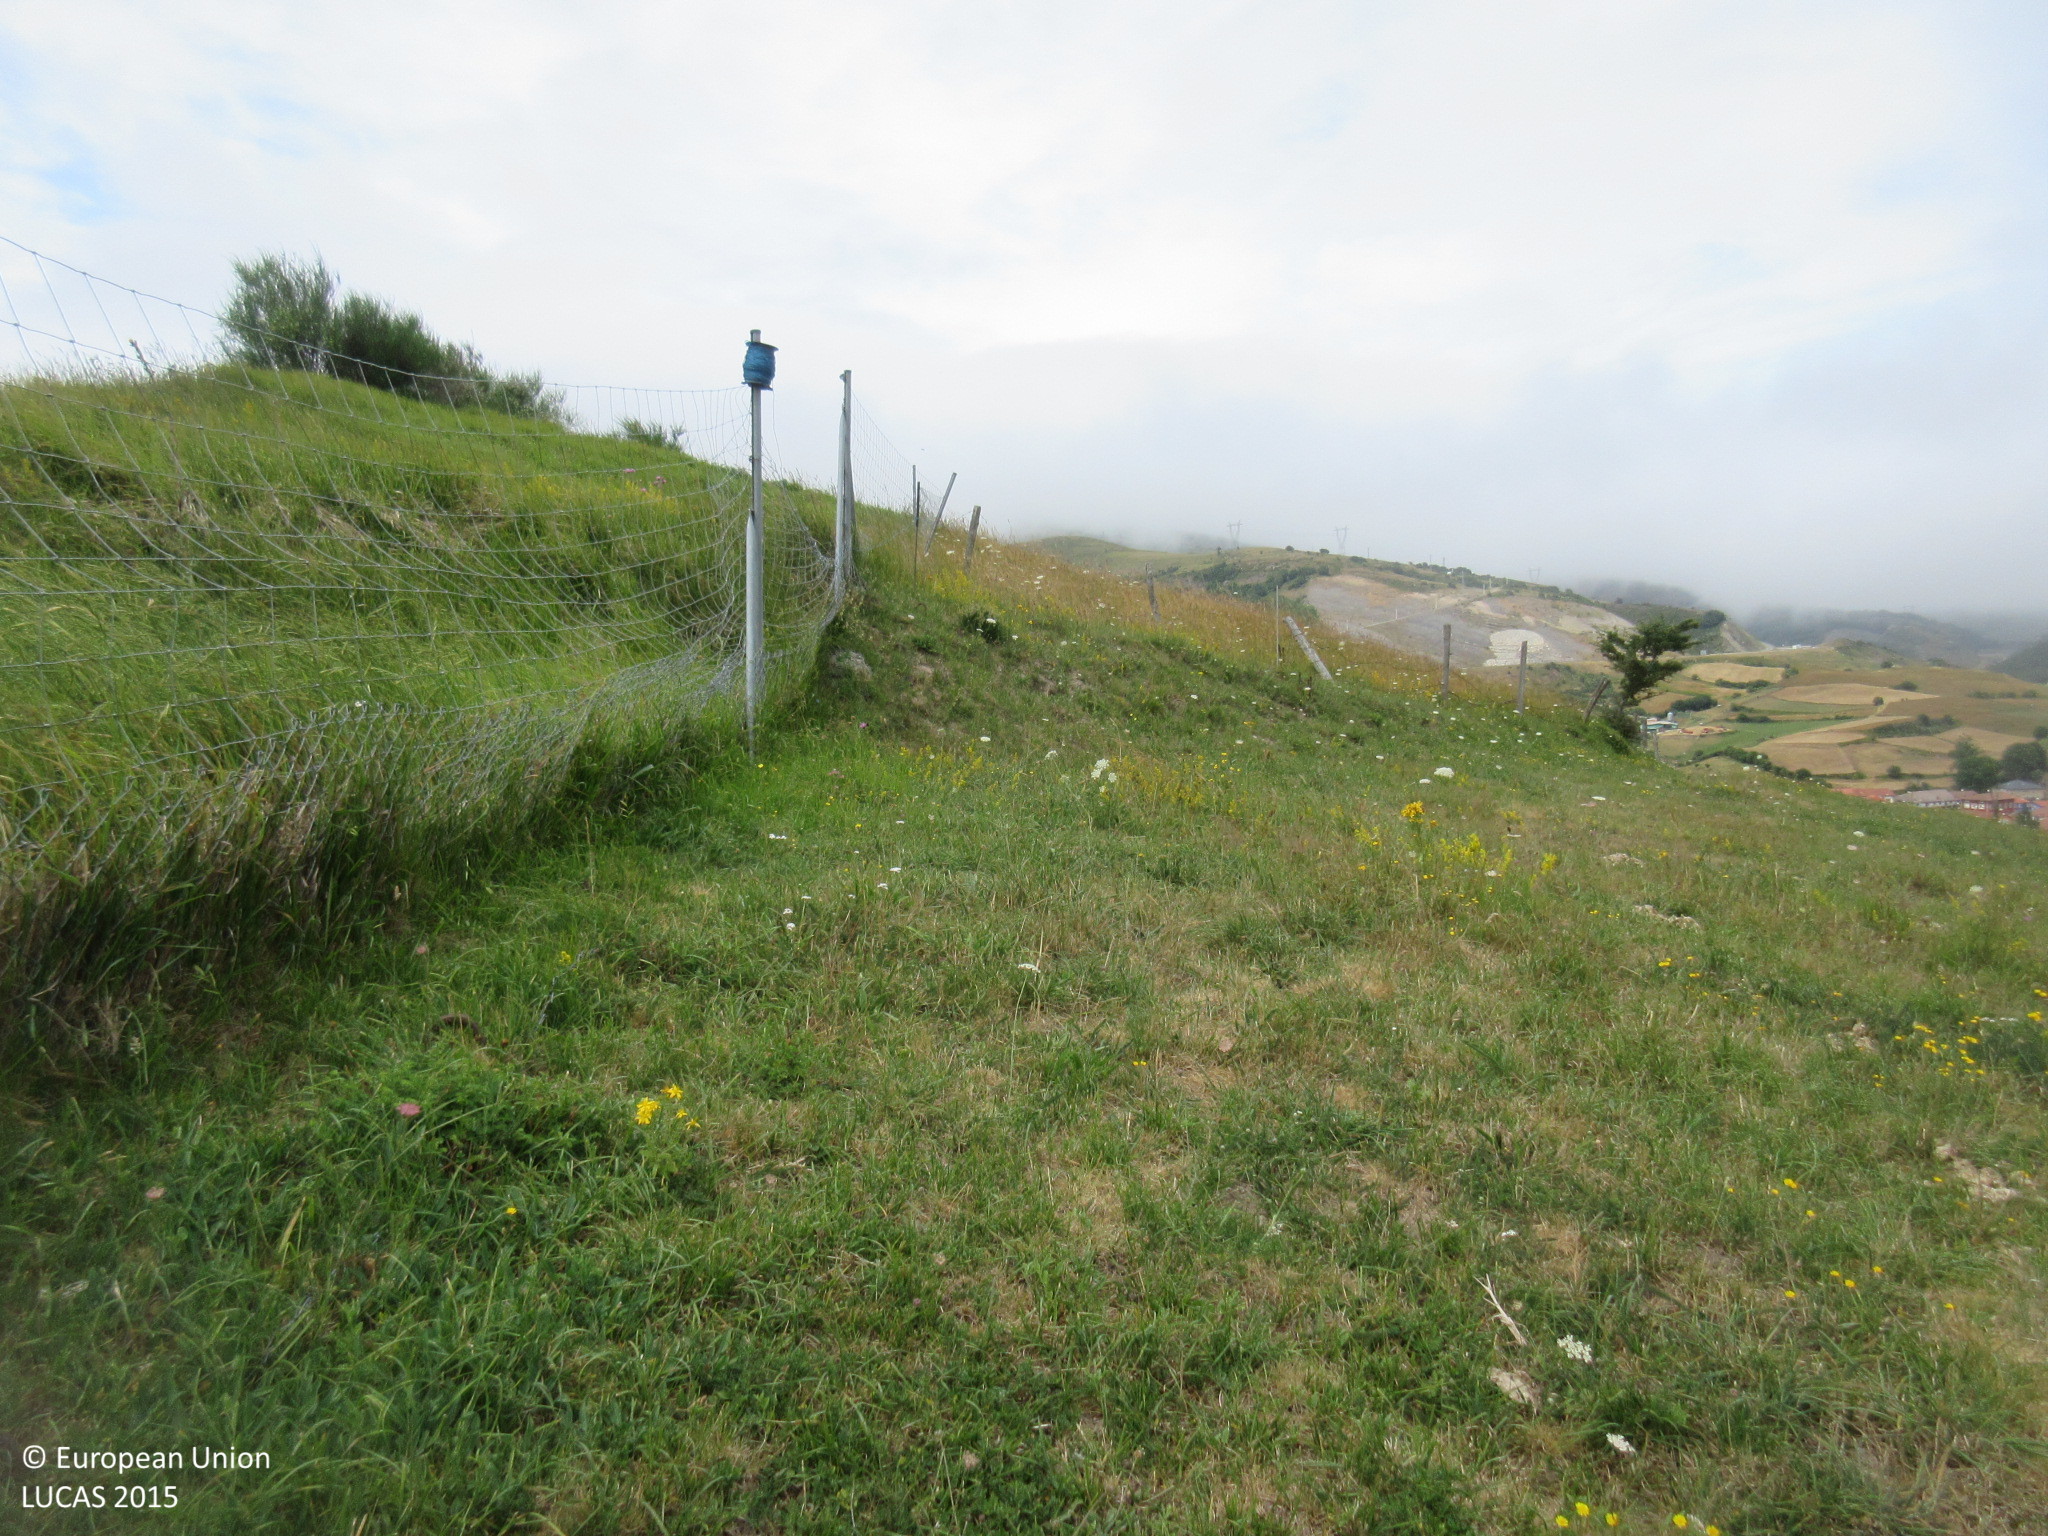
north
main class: Grassland
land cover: Grassland without tree/shrub cover
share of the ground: > 75 %
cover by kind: herbaceous plants 100 %
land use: Agriculture (excluding fallow land and kitchen gardens)
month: July
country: ES
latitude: 43.0131
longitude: -4.1230
